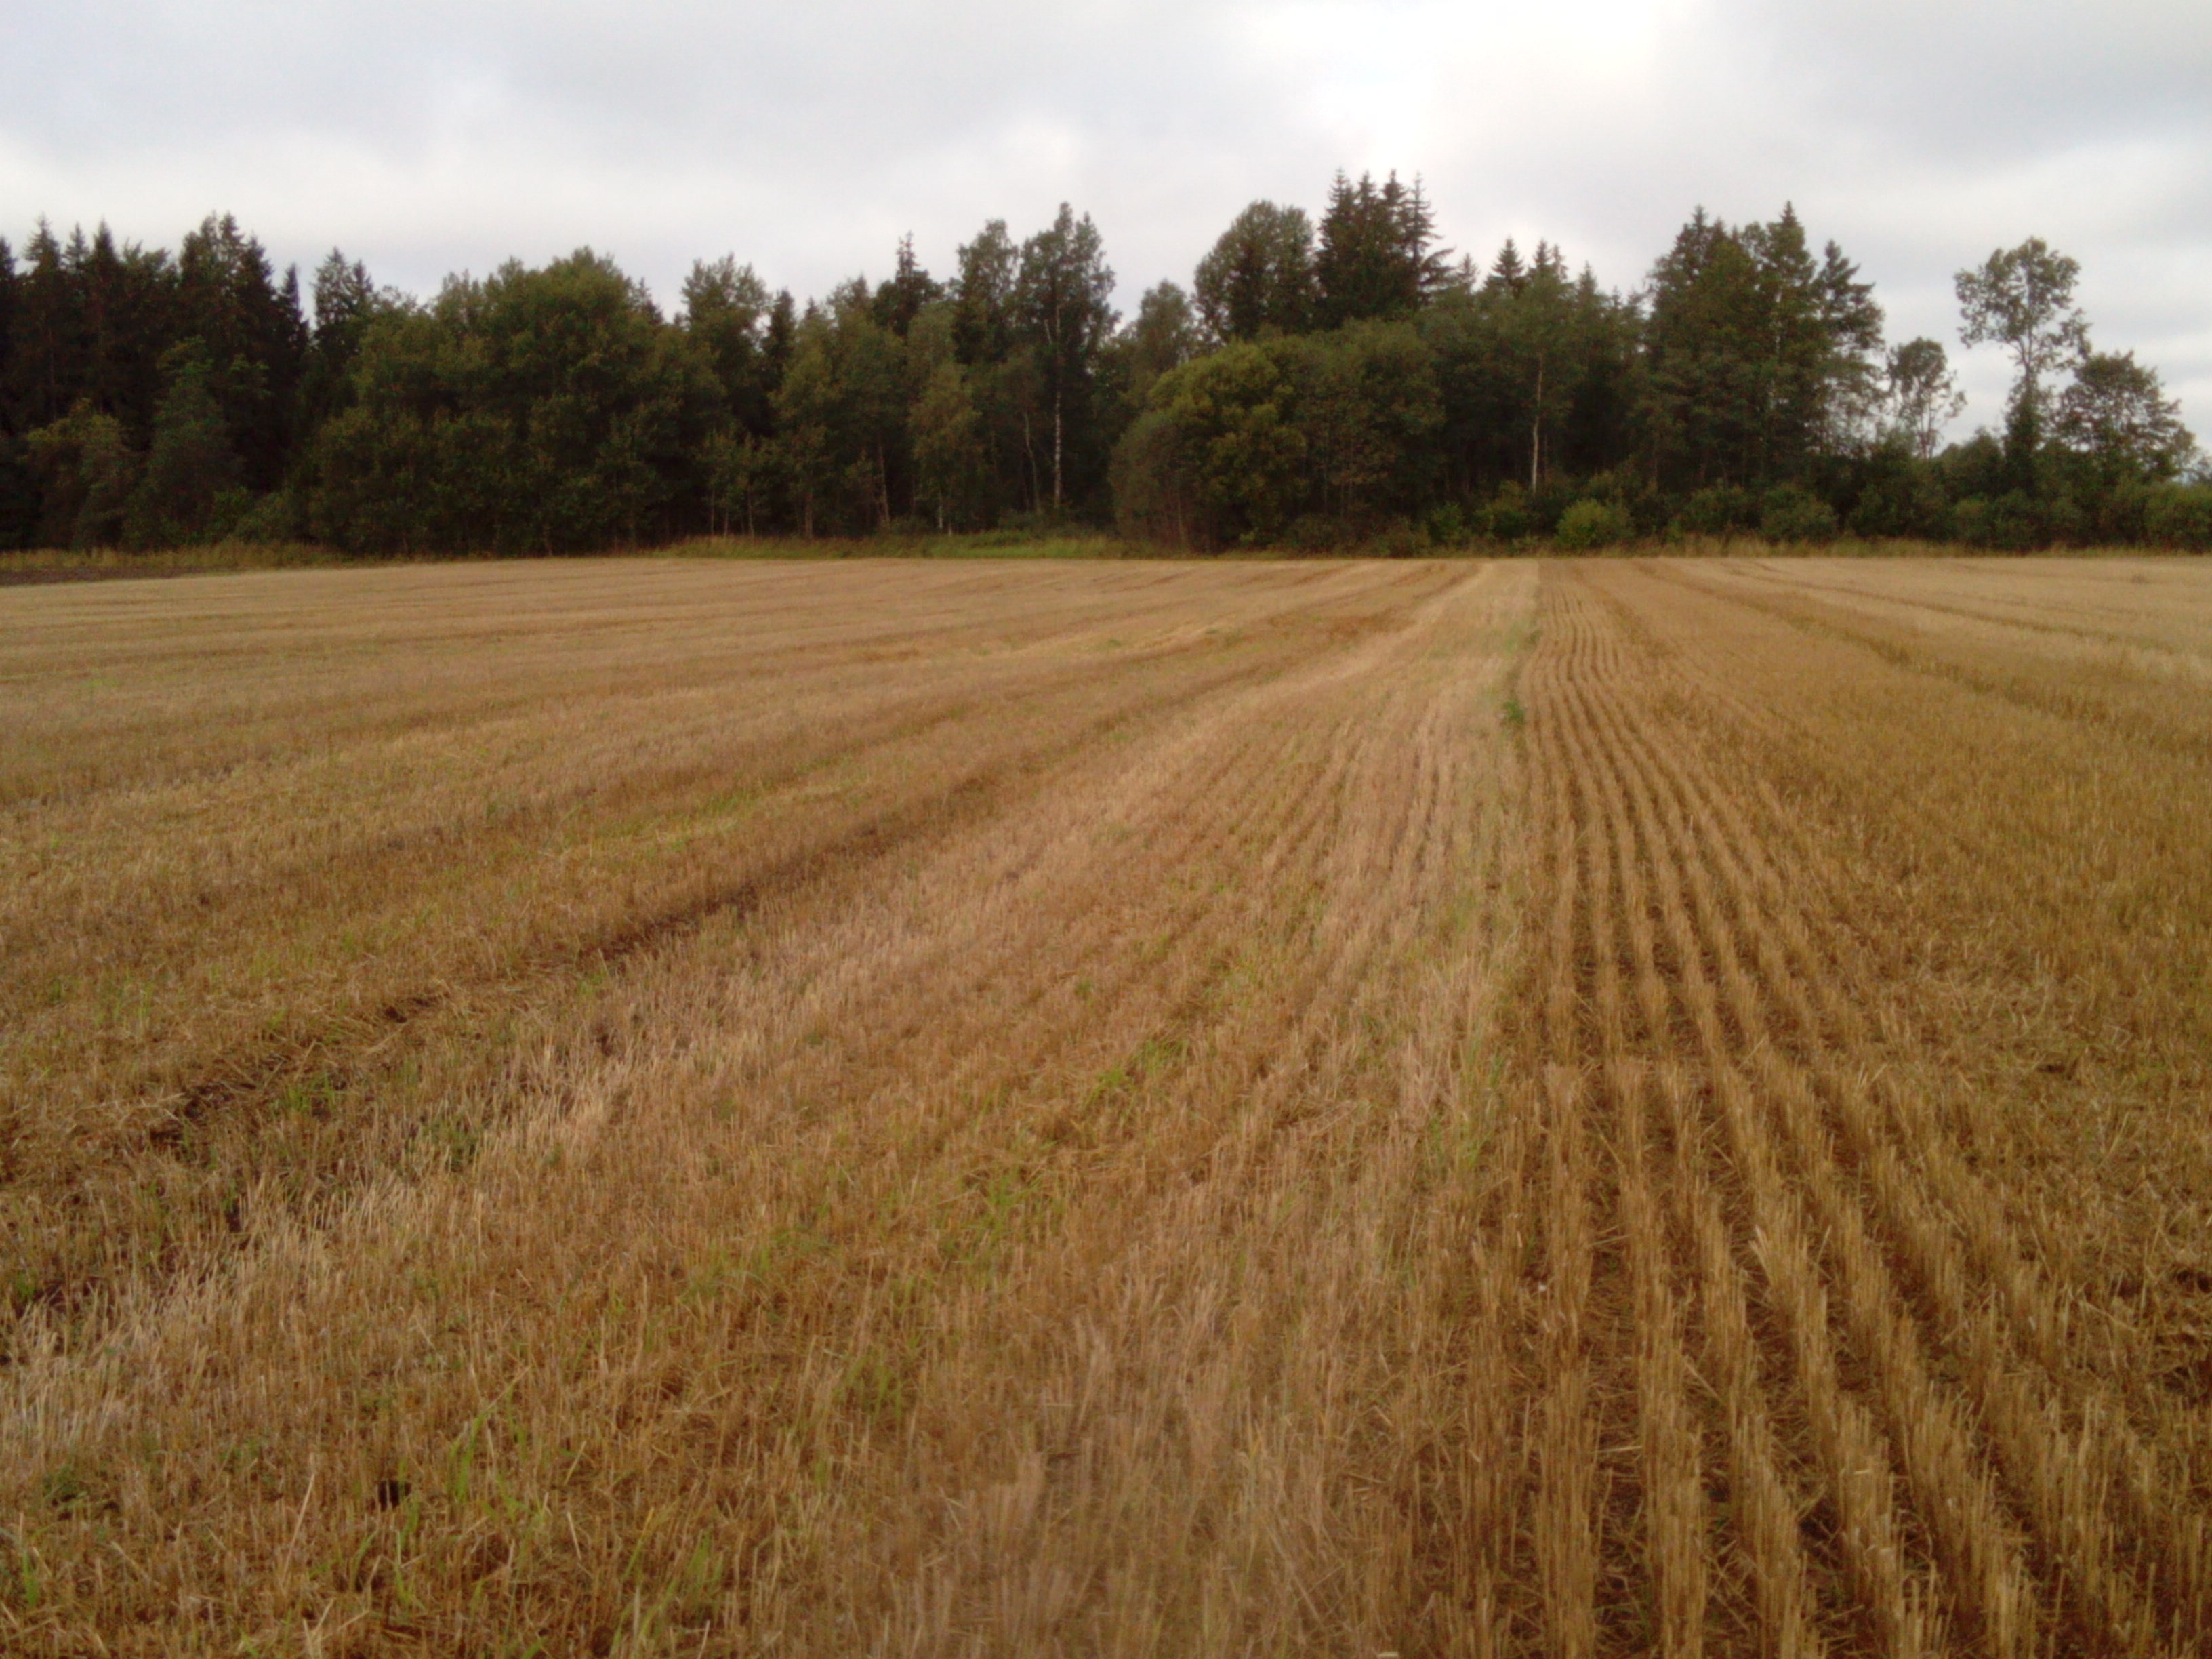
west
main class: Cropland
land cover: Common wheat
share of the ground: > 75 %
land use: Agriculture (excluding fallow land and kitchen gardens)
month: September
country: LT
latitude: 55.9531
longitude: 22.8944
